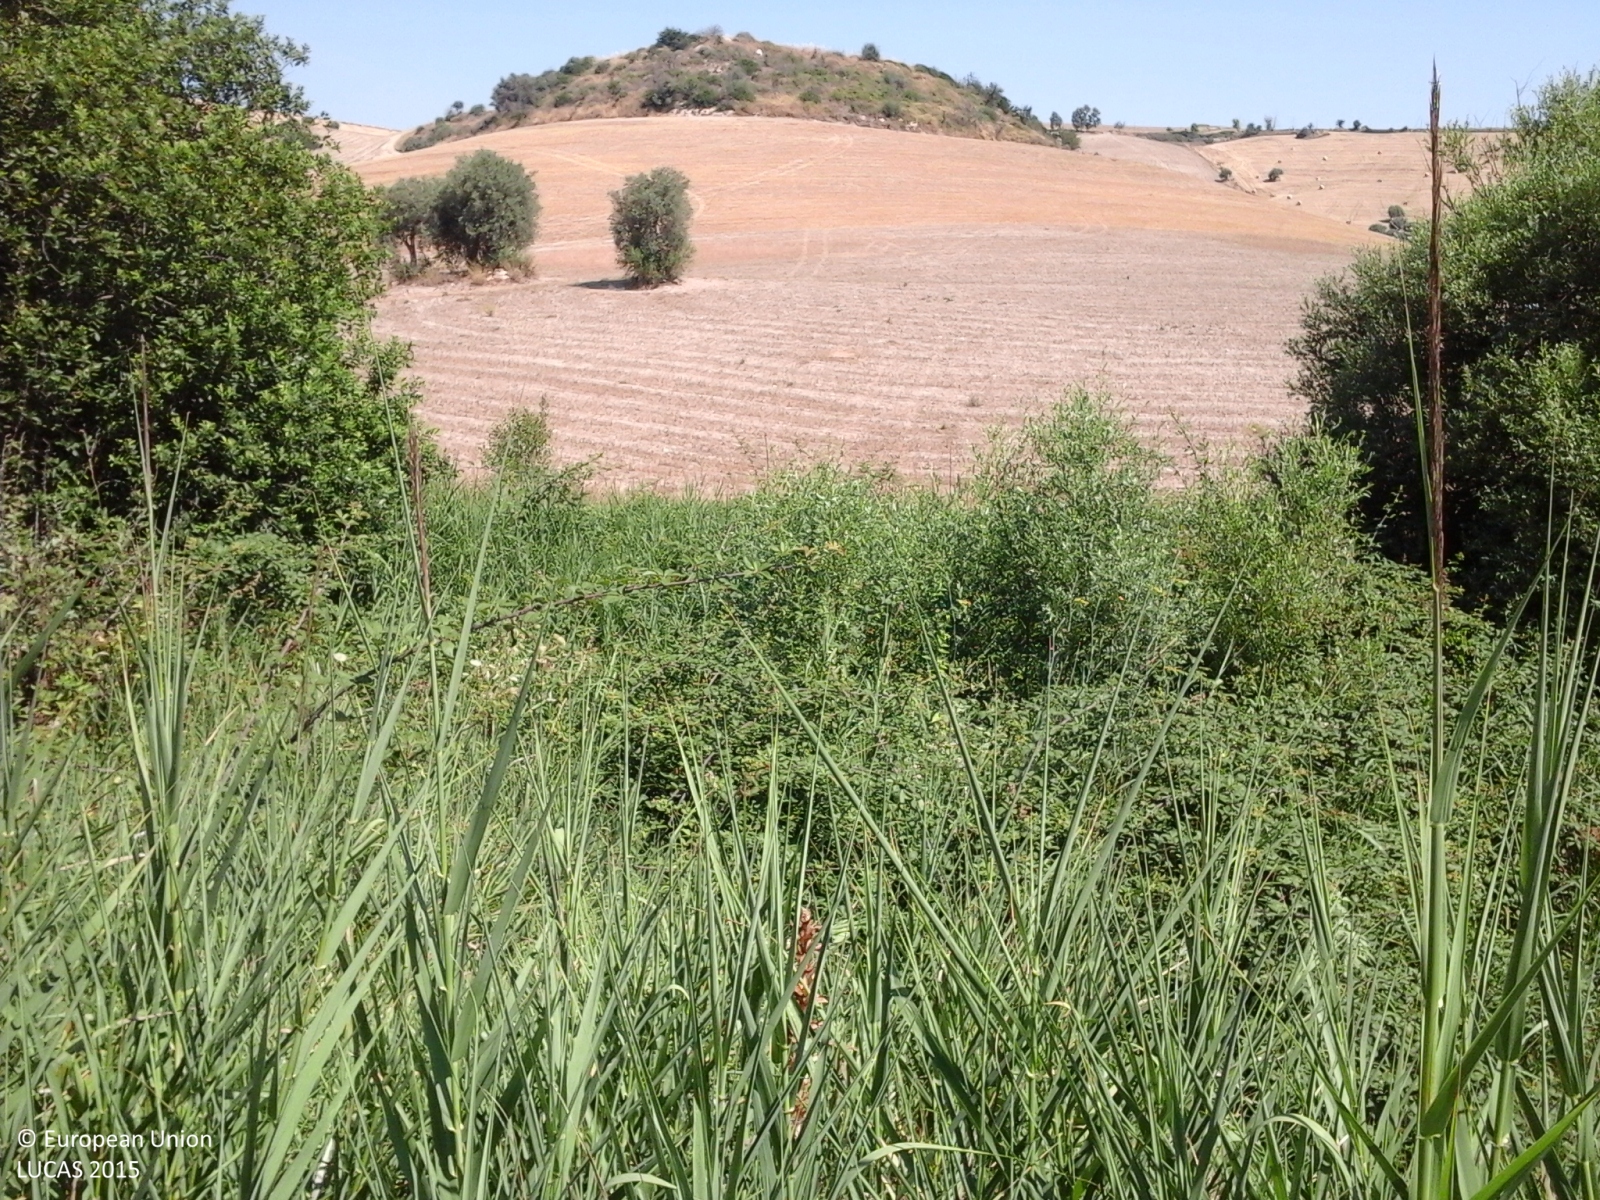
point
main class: Cropland
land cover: Mixed cereals for fodder
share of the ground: > 75 %
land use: Agriculture (excluding fallow land and kitchen gardens)
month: July
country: IT
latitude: 36.9860
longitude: 14.8716
